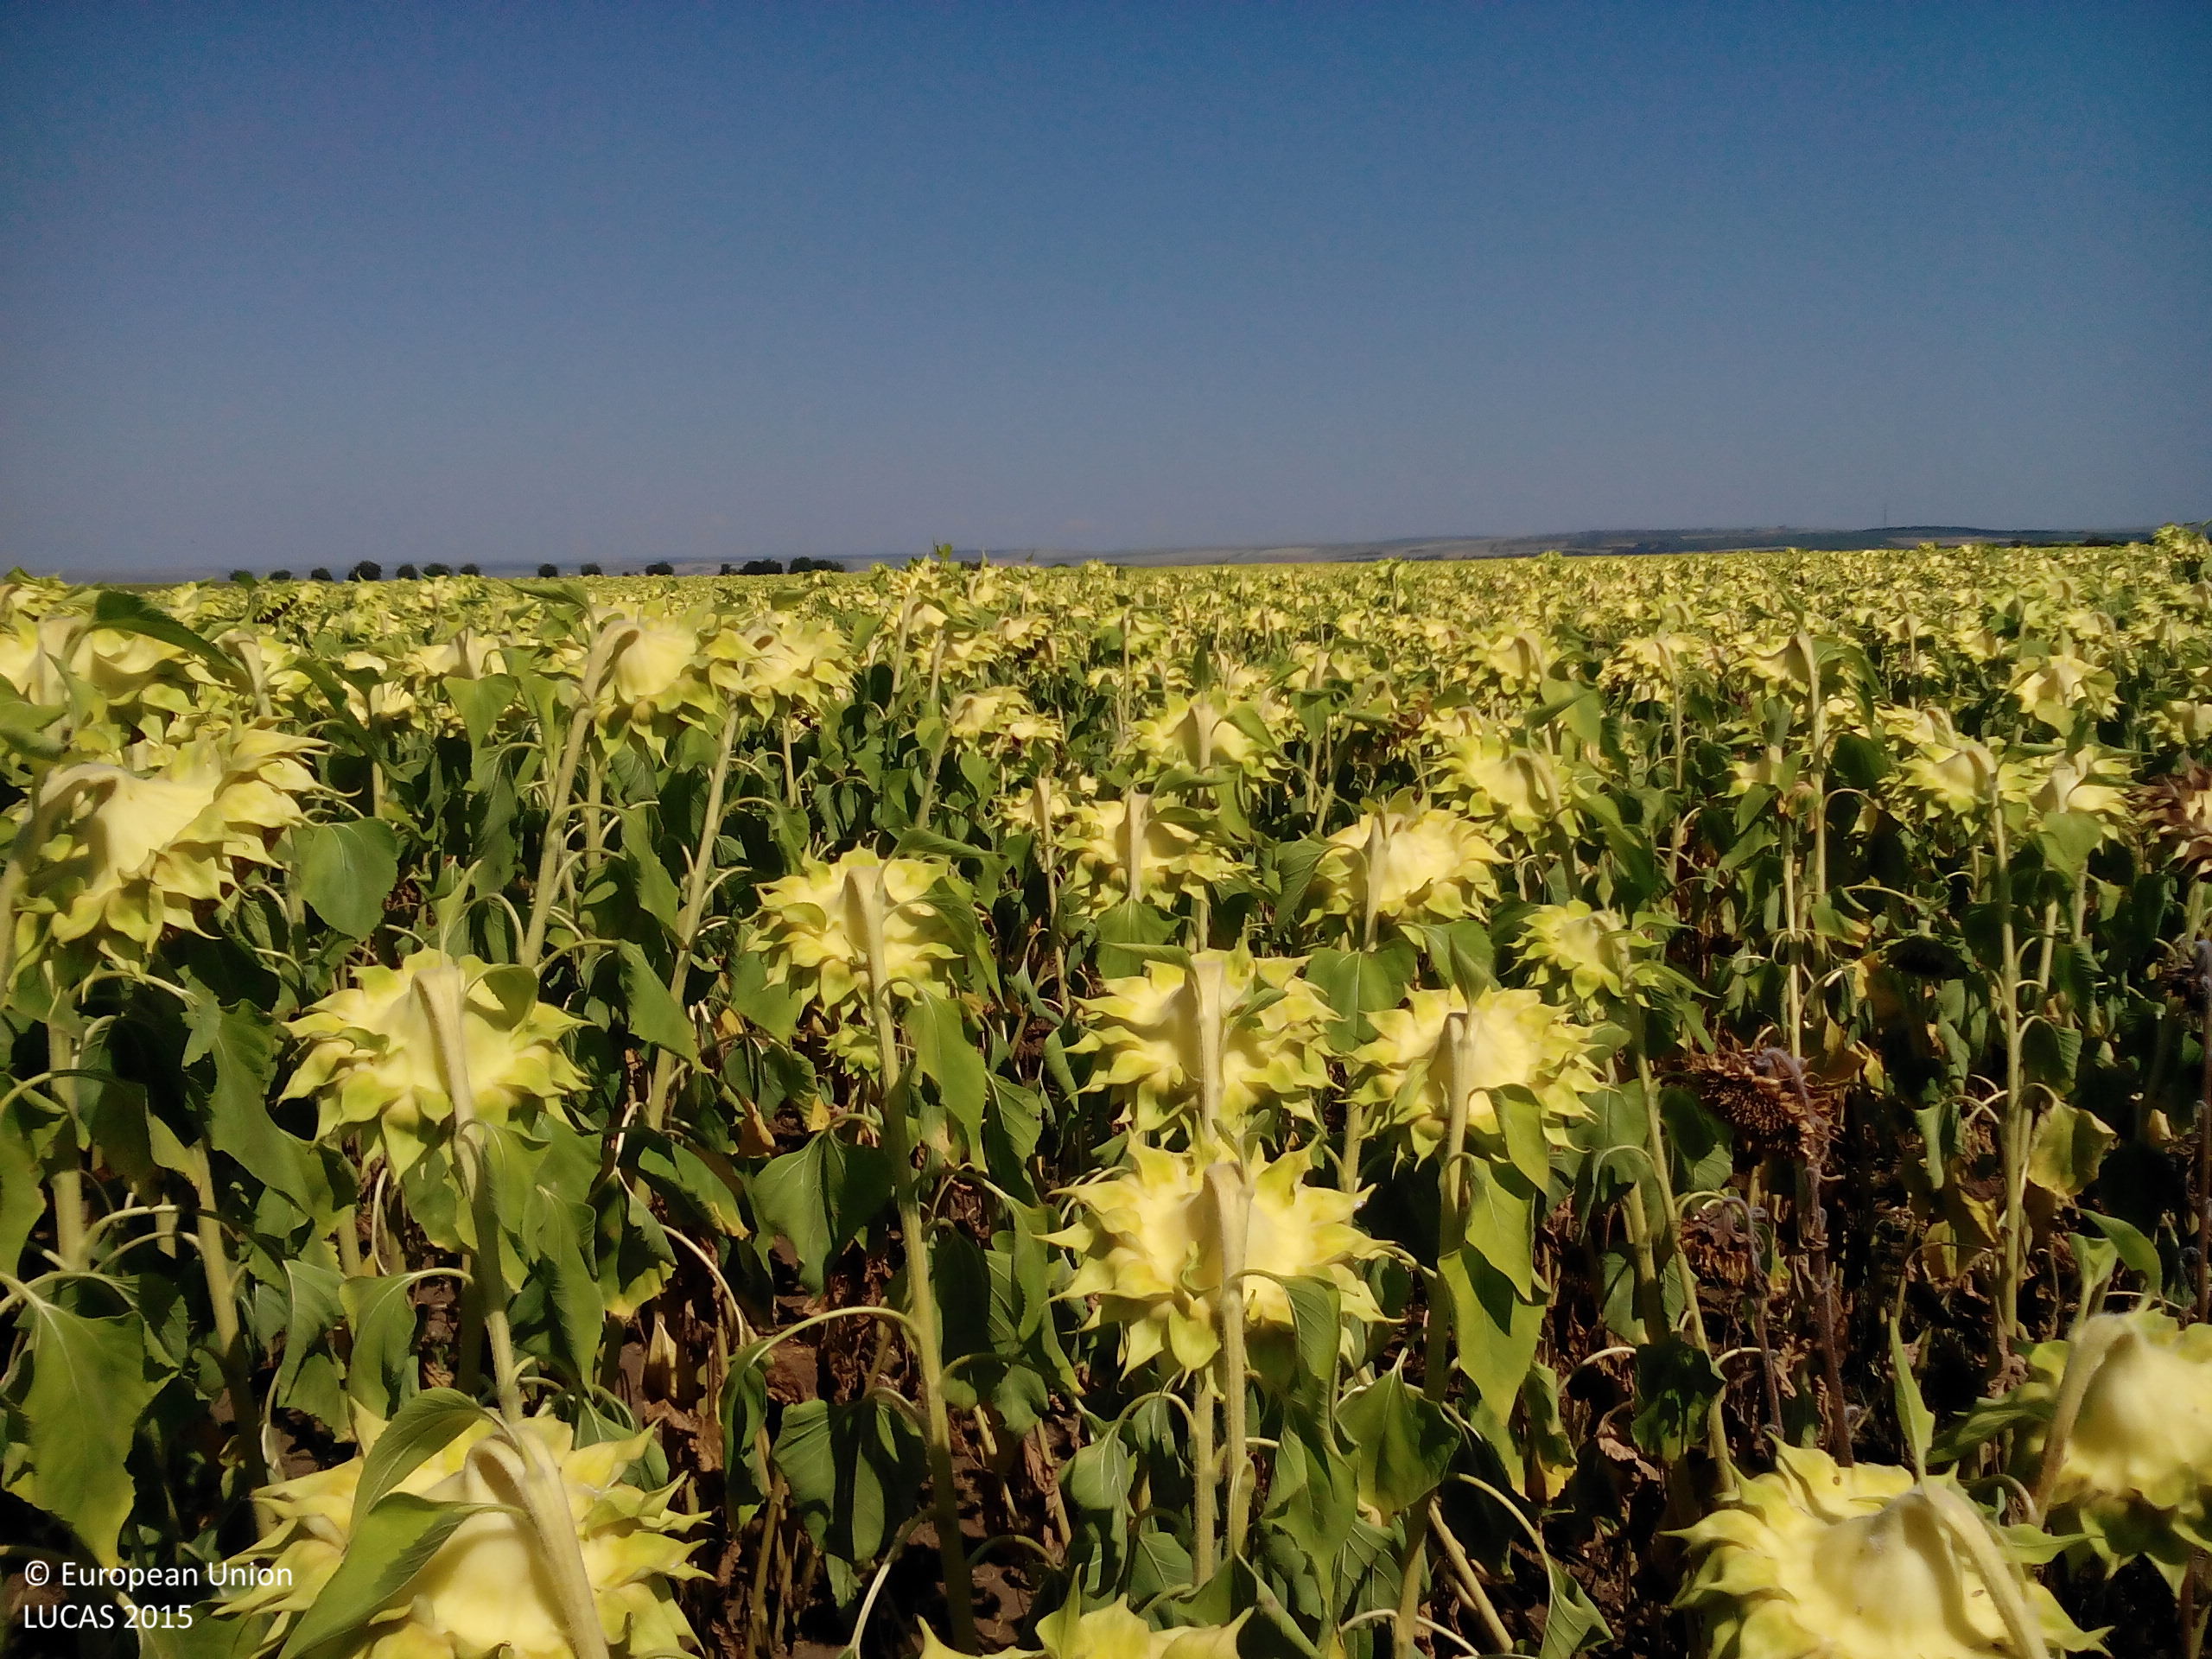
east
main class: Cropland
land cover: Sunflower
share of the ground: > 75 %
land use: Agriculture (excluding fallow land and kitchen gardens)
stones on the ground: < 10 %
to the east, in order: Sunflower
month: July
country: BG
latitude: 43.3145
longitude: 24.3221
